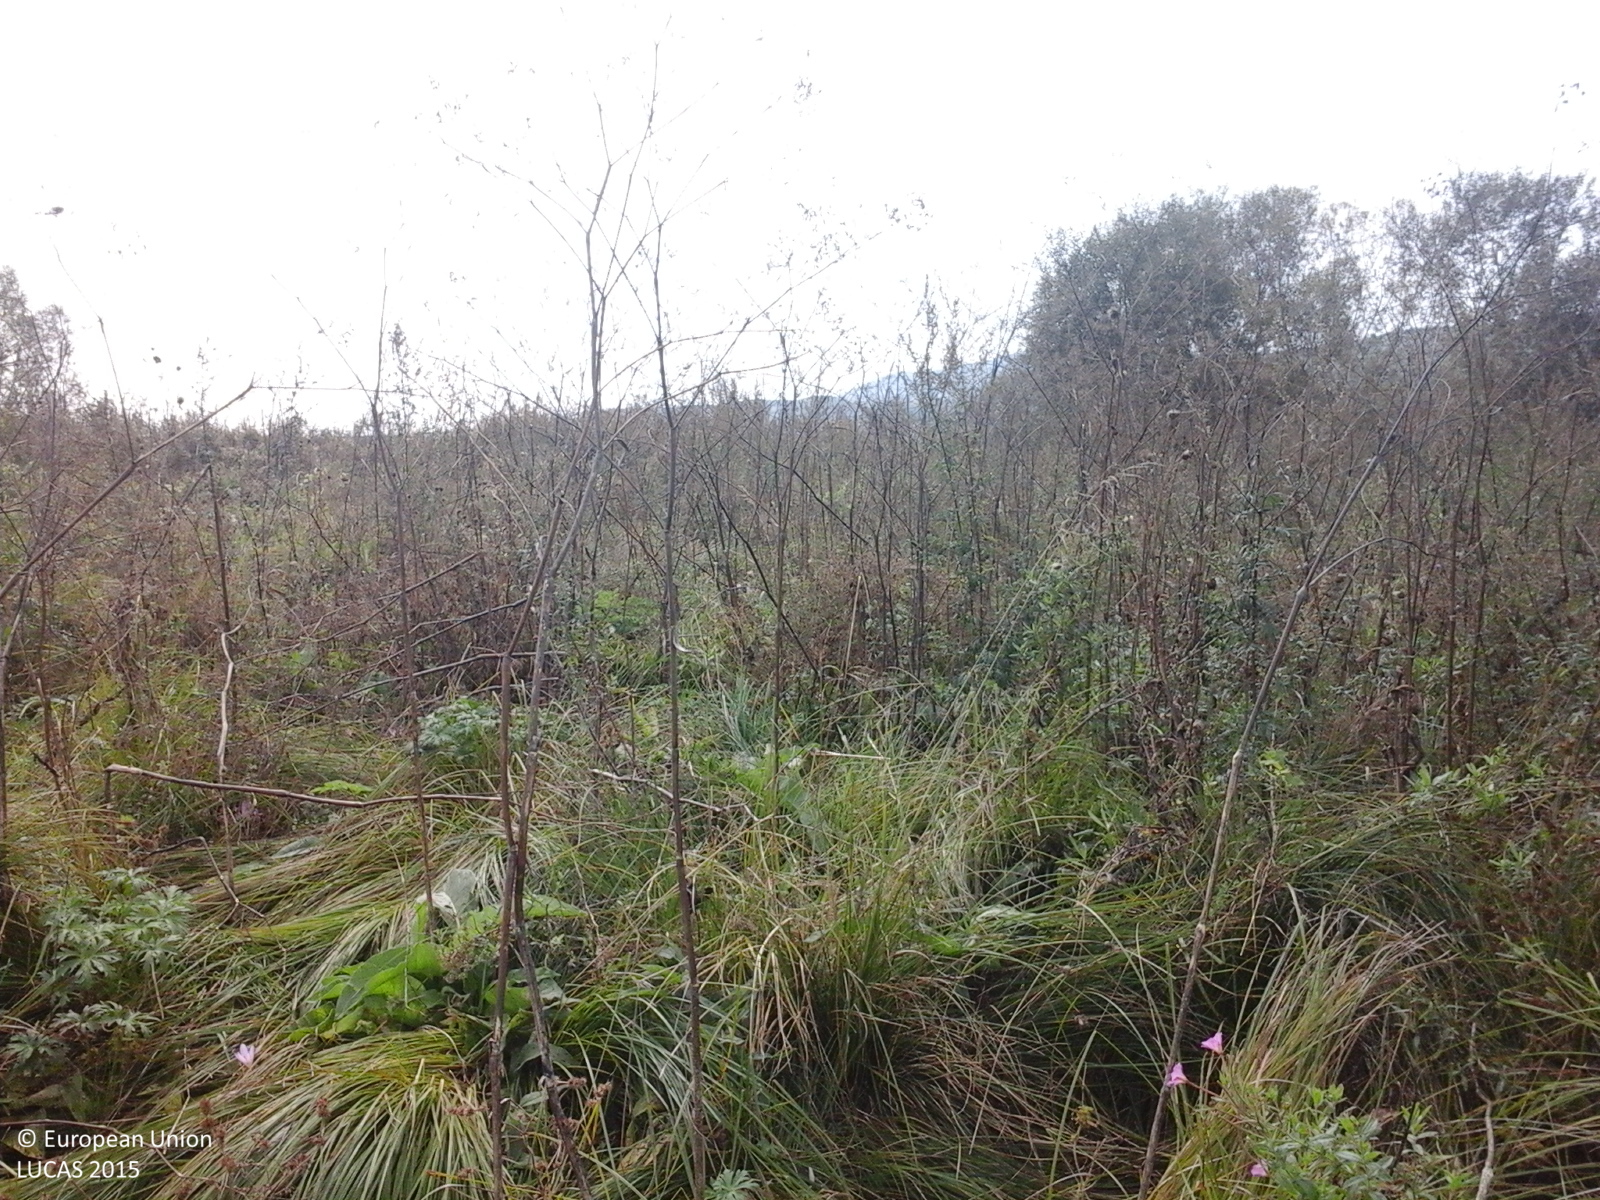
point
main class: Grassland
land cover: Spontaneously vegetated surfaces
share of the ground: > 75 %
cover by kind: herbaceous plants 100 %
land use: Fallow land
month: September
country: RO
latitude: 46.8571
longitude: 22.9273
